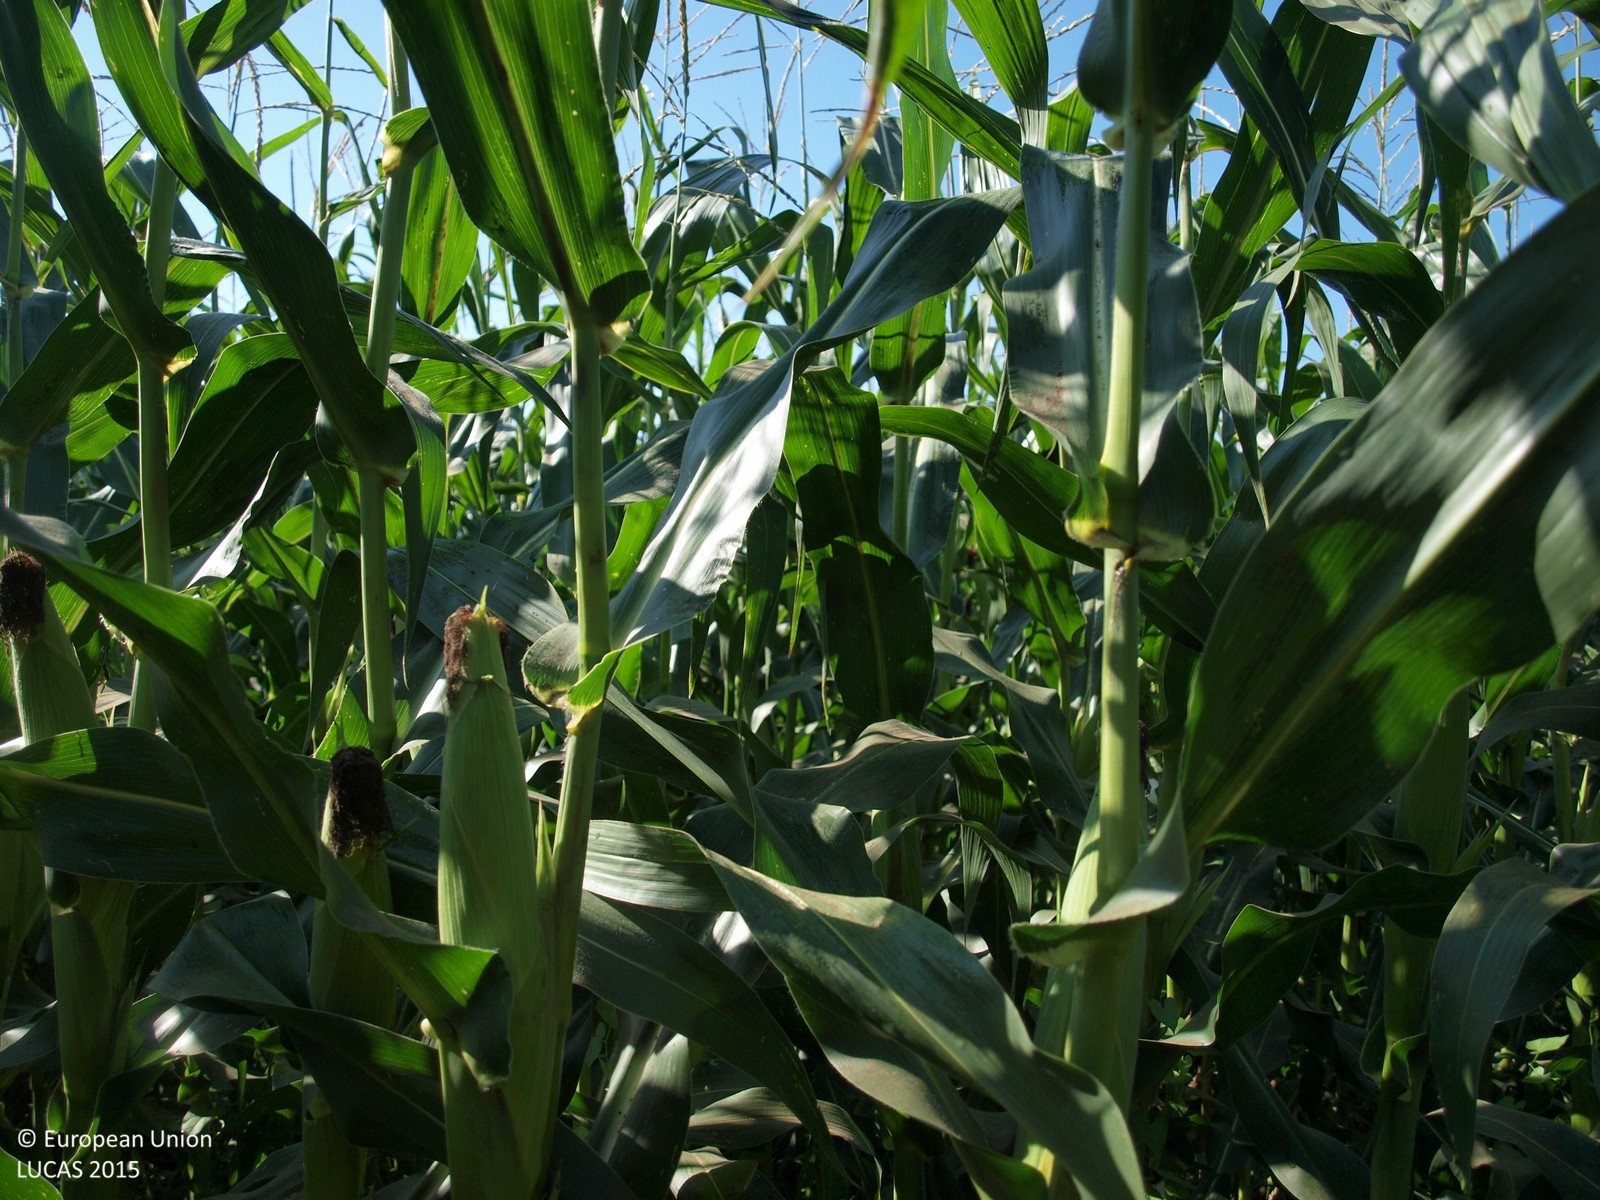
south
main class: Cropland
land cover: Maize
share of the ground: > 75 %
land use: Agriculture (excluding fallow land and kitchen gardens)
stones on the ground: < 10 %
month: August
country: HR
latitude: 46.0036
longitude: 16.2879
